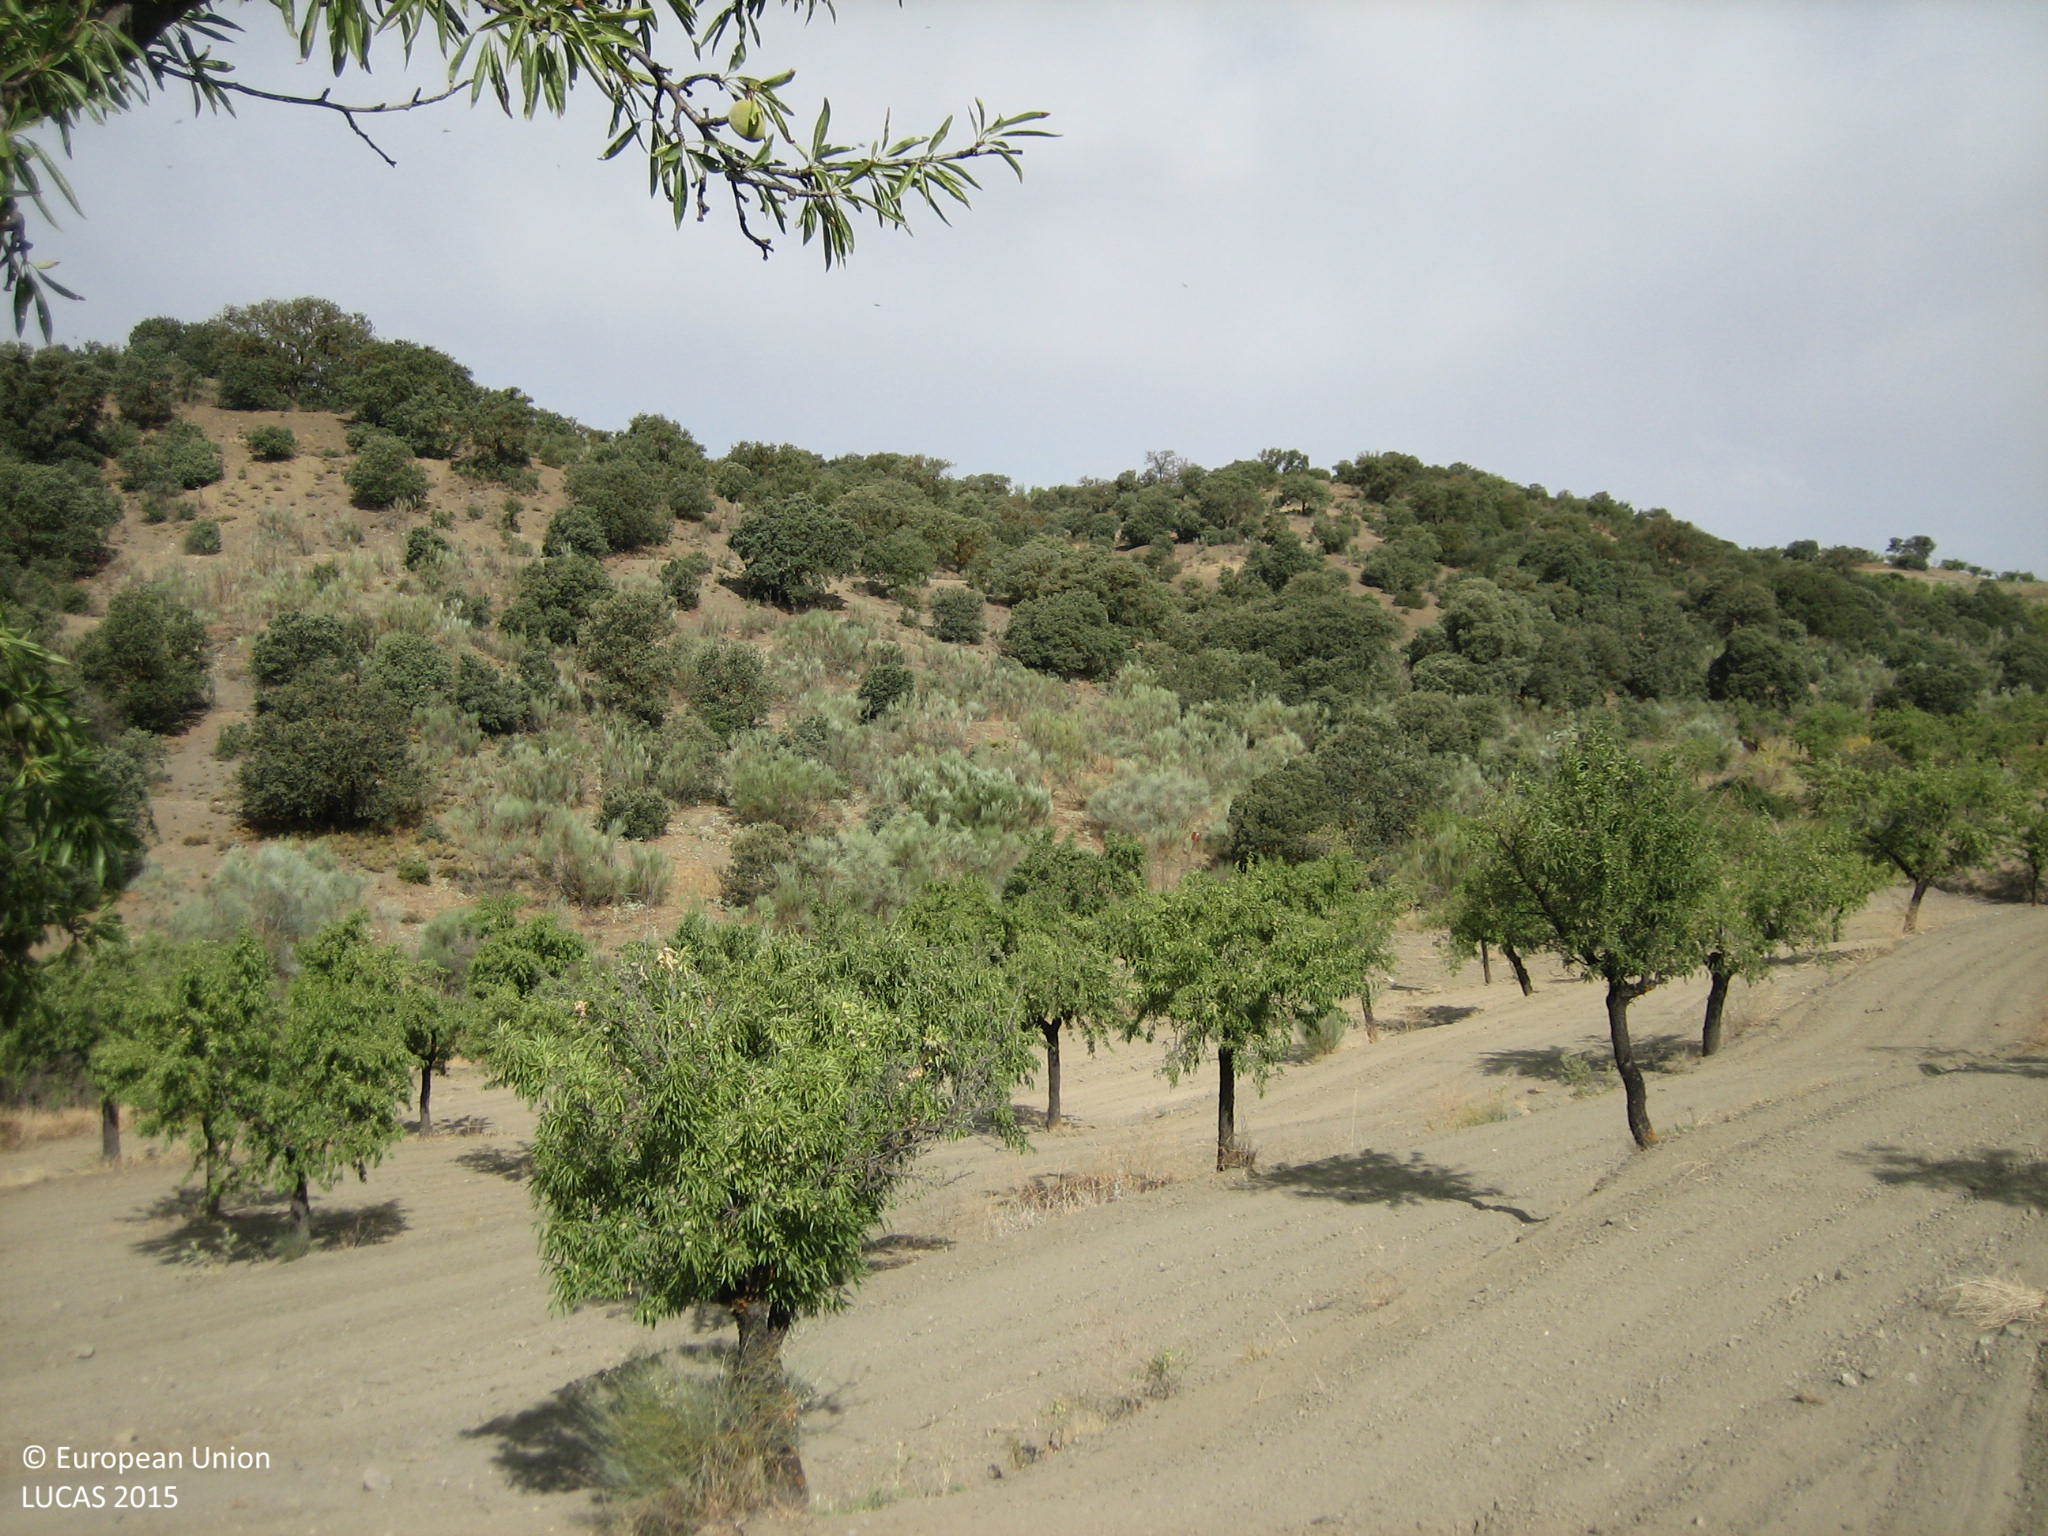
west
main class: Cropland
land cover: Nuts trees
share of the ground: 10 - 25 %
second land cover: Other bare soil
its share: > 75 %
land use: Agriculture (excluding fallow land and kitchen gardens)
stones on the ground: < 10 %
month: July
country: ES
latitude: 37.5398
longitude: -2.2409
